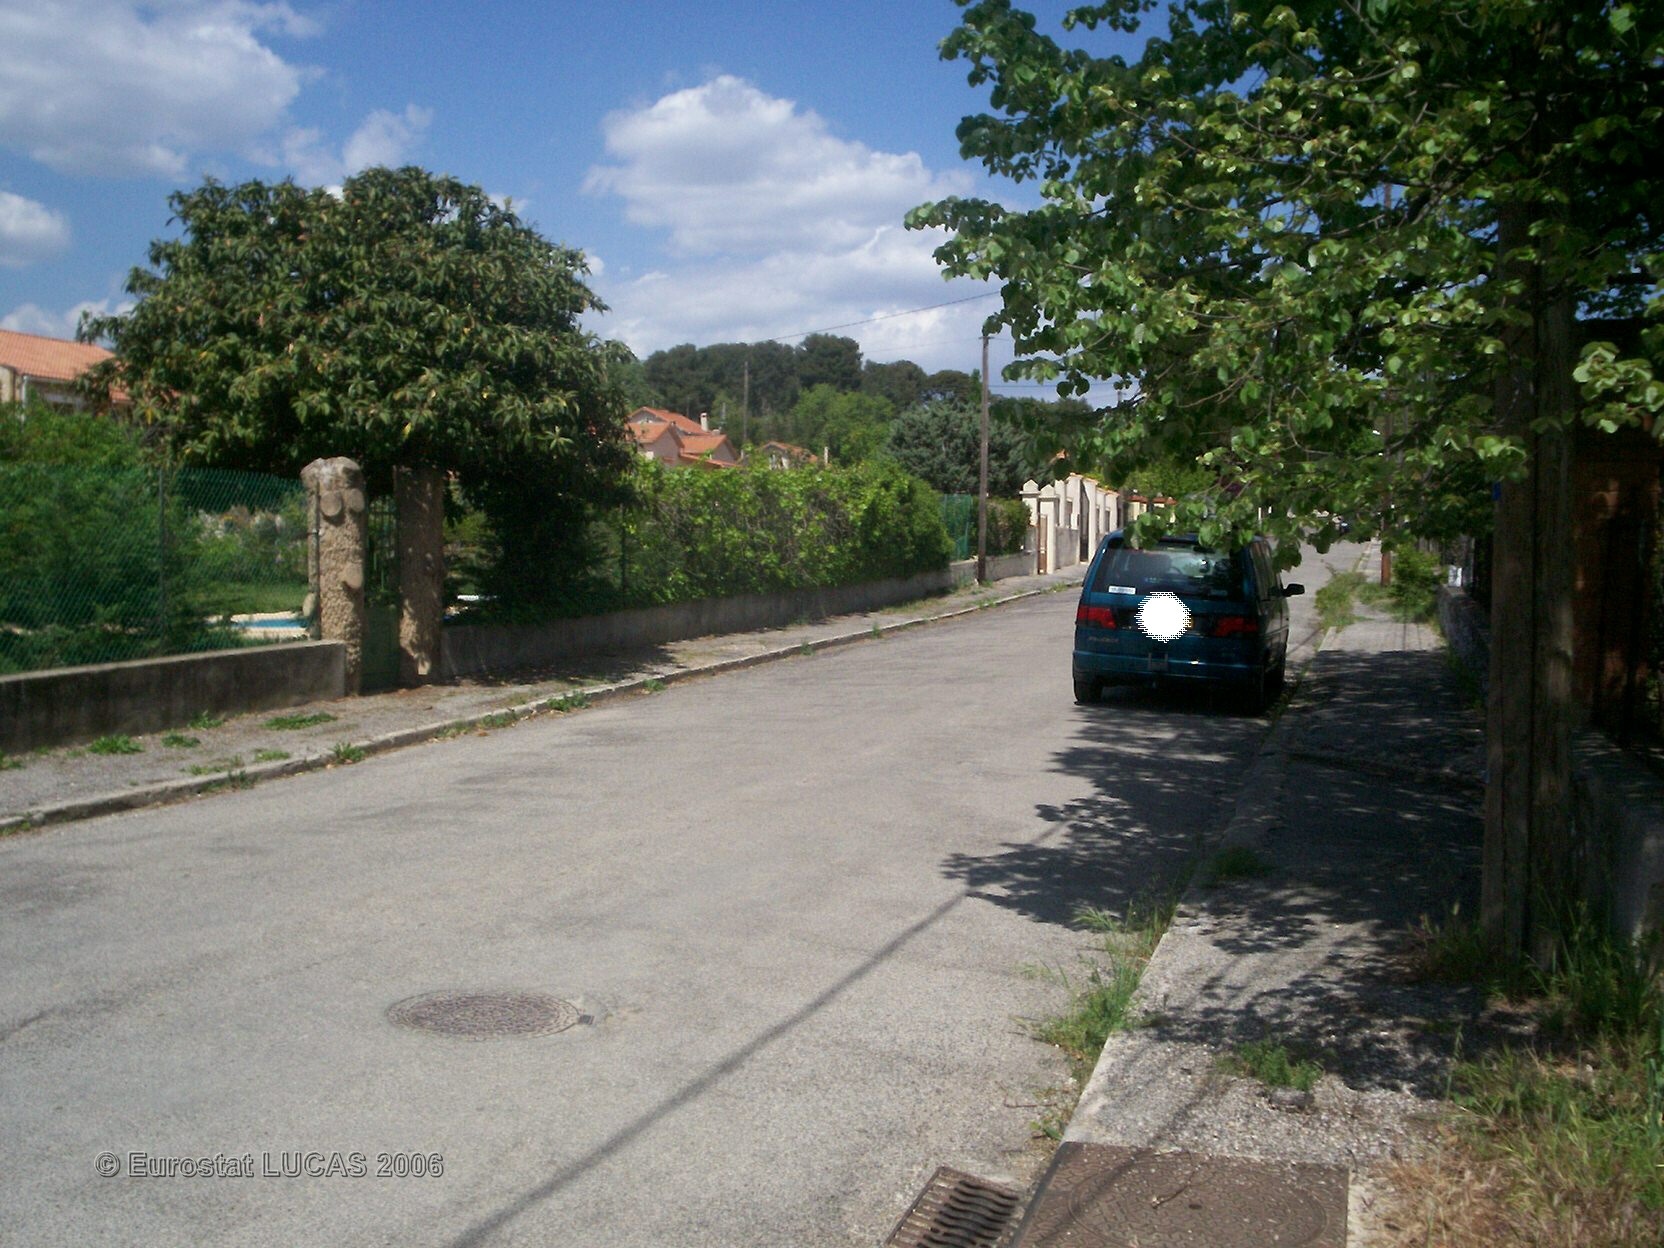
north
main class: Grassland
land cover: Grassland with sparse tree/shrub cover
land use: Residential
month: April
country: FR
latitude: 43.2980
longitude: 5.5604
